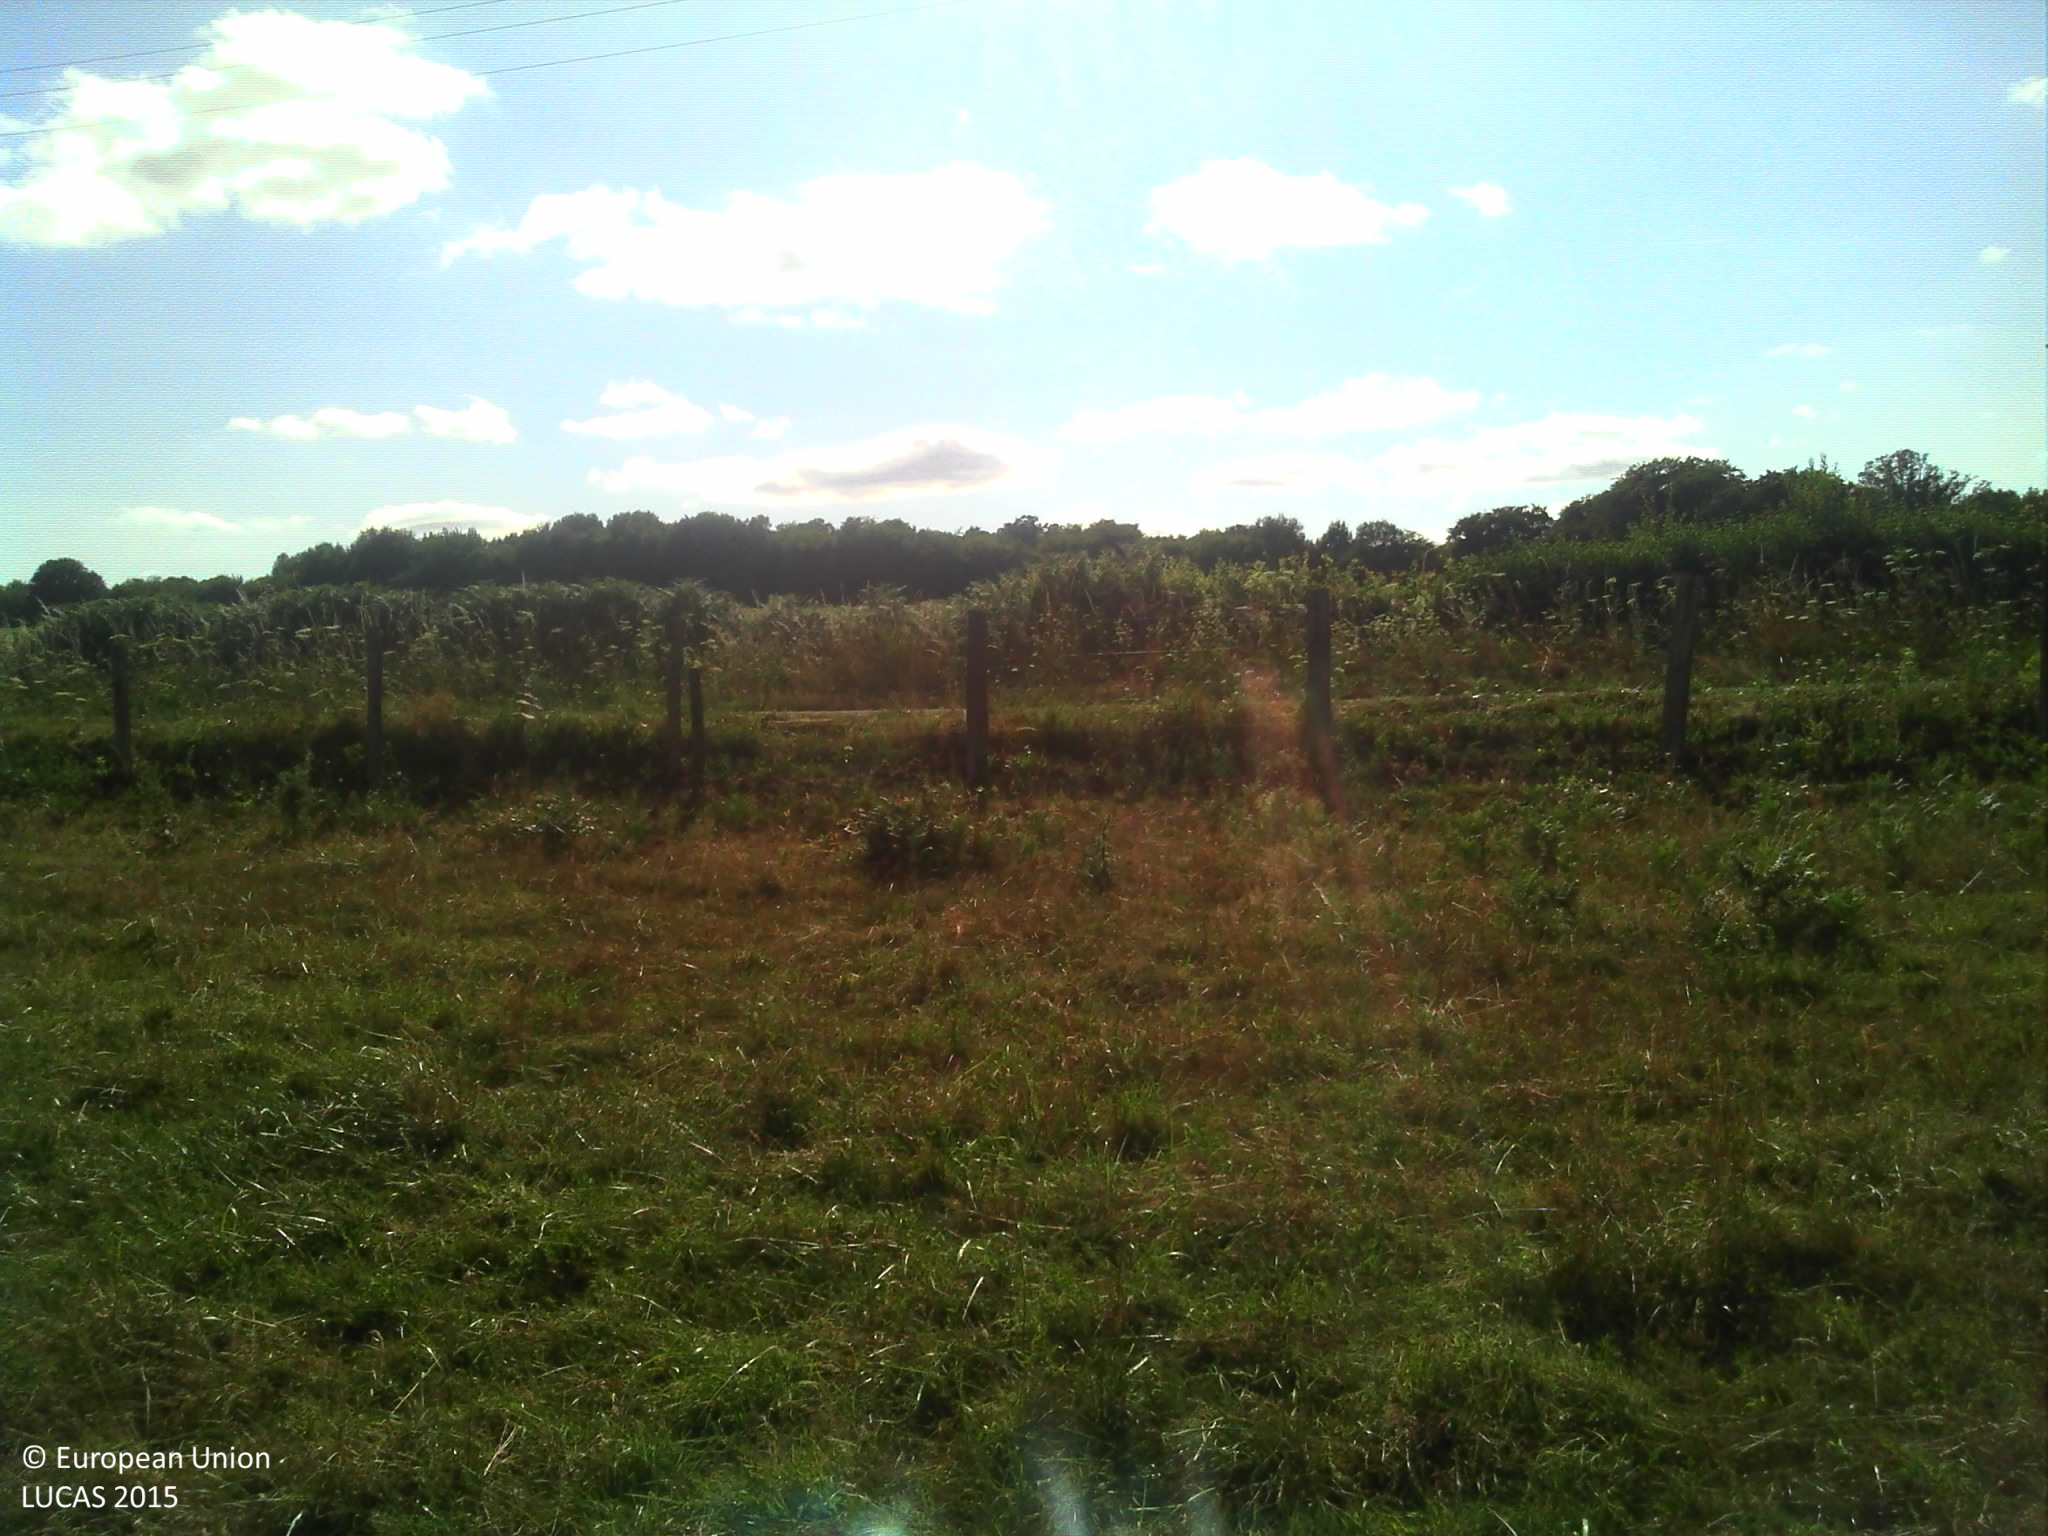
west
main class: Grassland
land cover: Grassland without tree/shrub cover
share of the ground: > 75 %
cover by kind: herbaceous plants 100 %
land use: Agriculture (excluding fallow land and kitchen gardens)
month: July
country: FR
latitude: 46.3072
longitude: 1.5639
